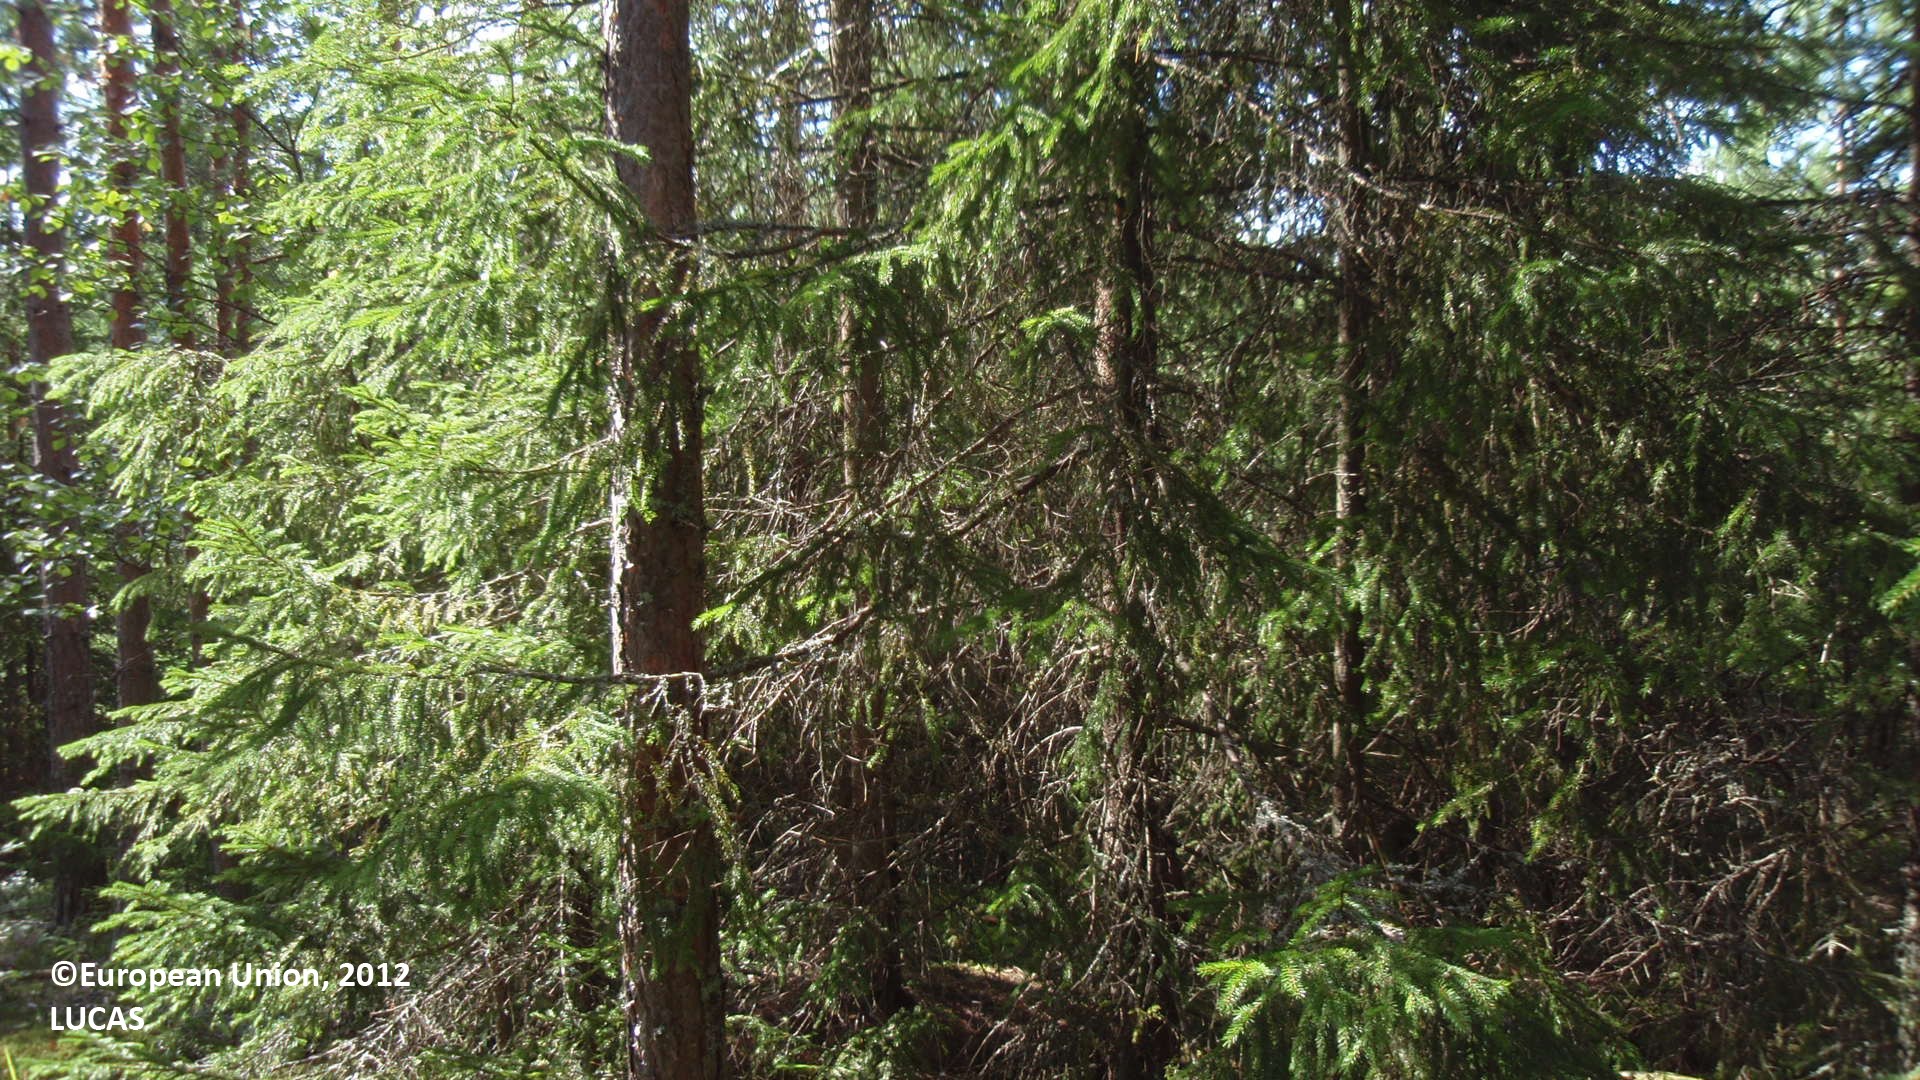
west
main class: Woodland
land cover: Pine dominated coniferous woodland
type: boreal forest
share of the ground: 50 - 75 %
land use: Forestry
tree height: > 5 m
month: August
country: FI
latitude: 61.1539
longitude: 27.7478
